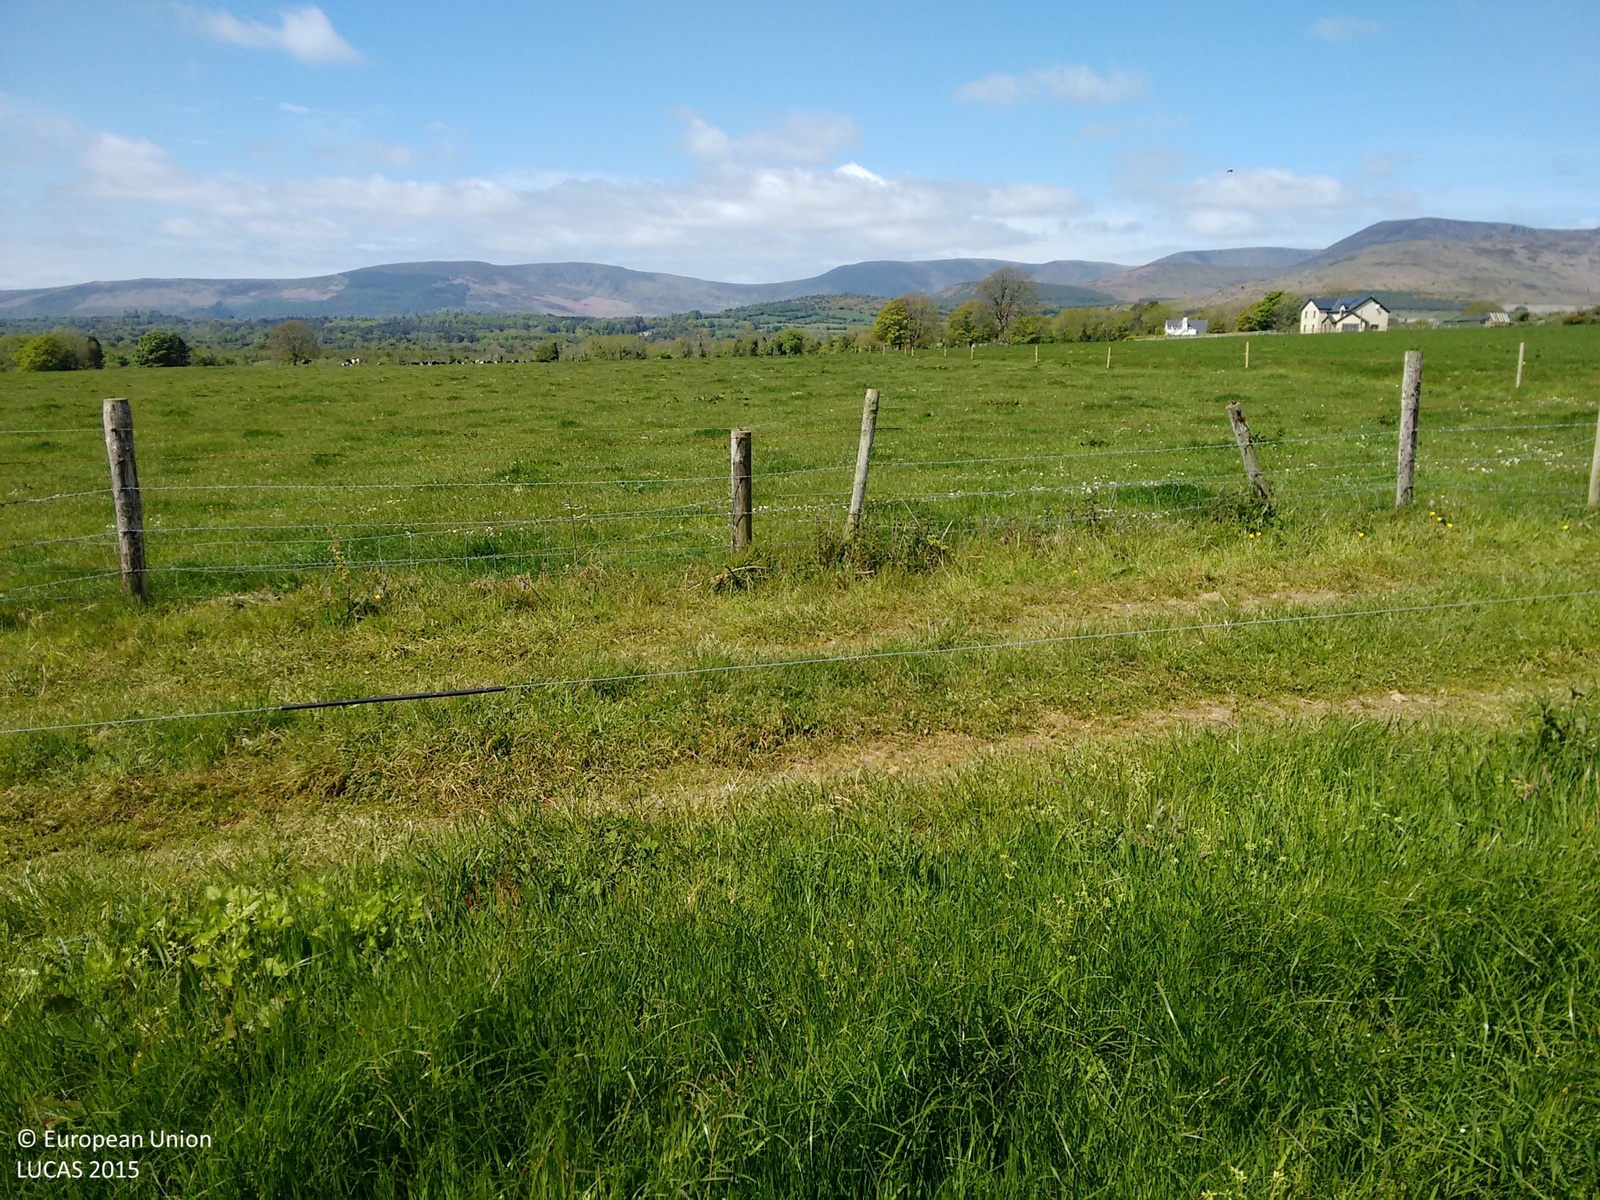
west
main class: Grassland
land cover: Grassland without tree/shrub cover
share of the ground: > 75 %
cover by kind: herbaceous plants 100 %
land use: Agriculture (excluding fallow land and kitchen gardens)
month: May
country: IE
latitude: 52.2091
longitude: -7.4704
